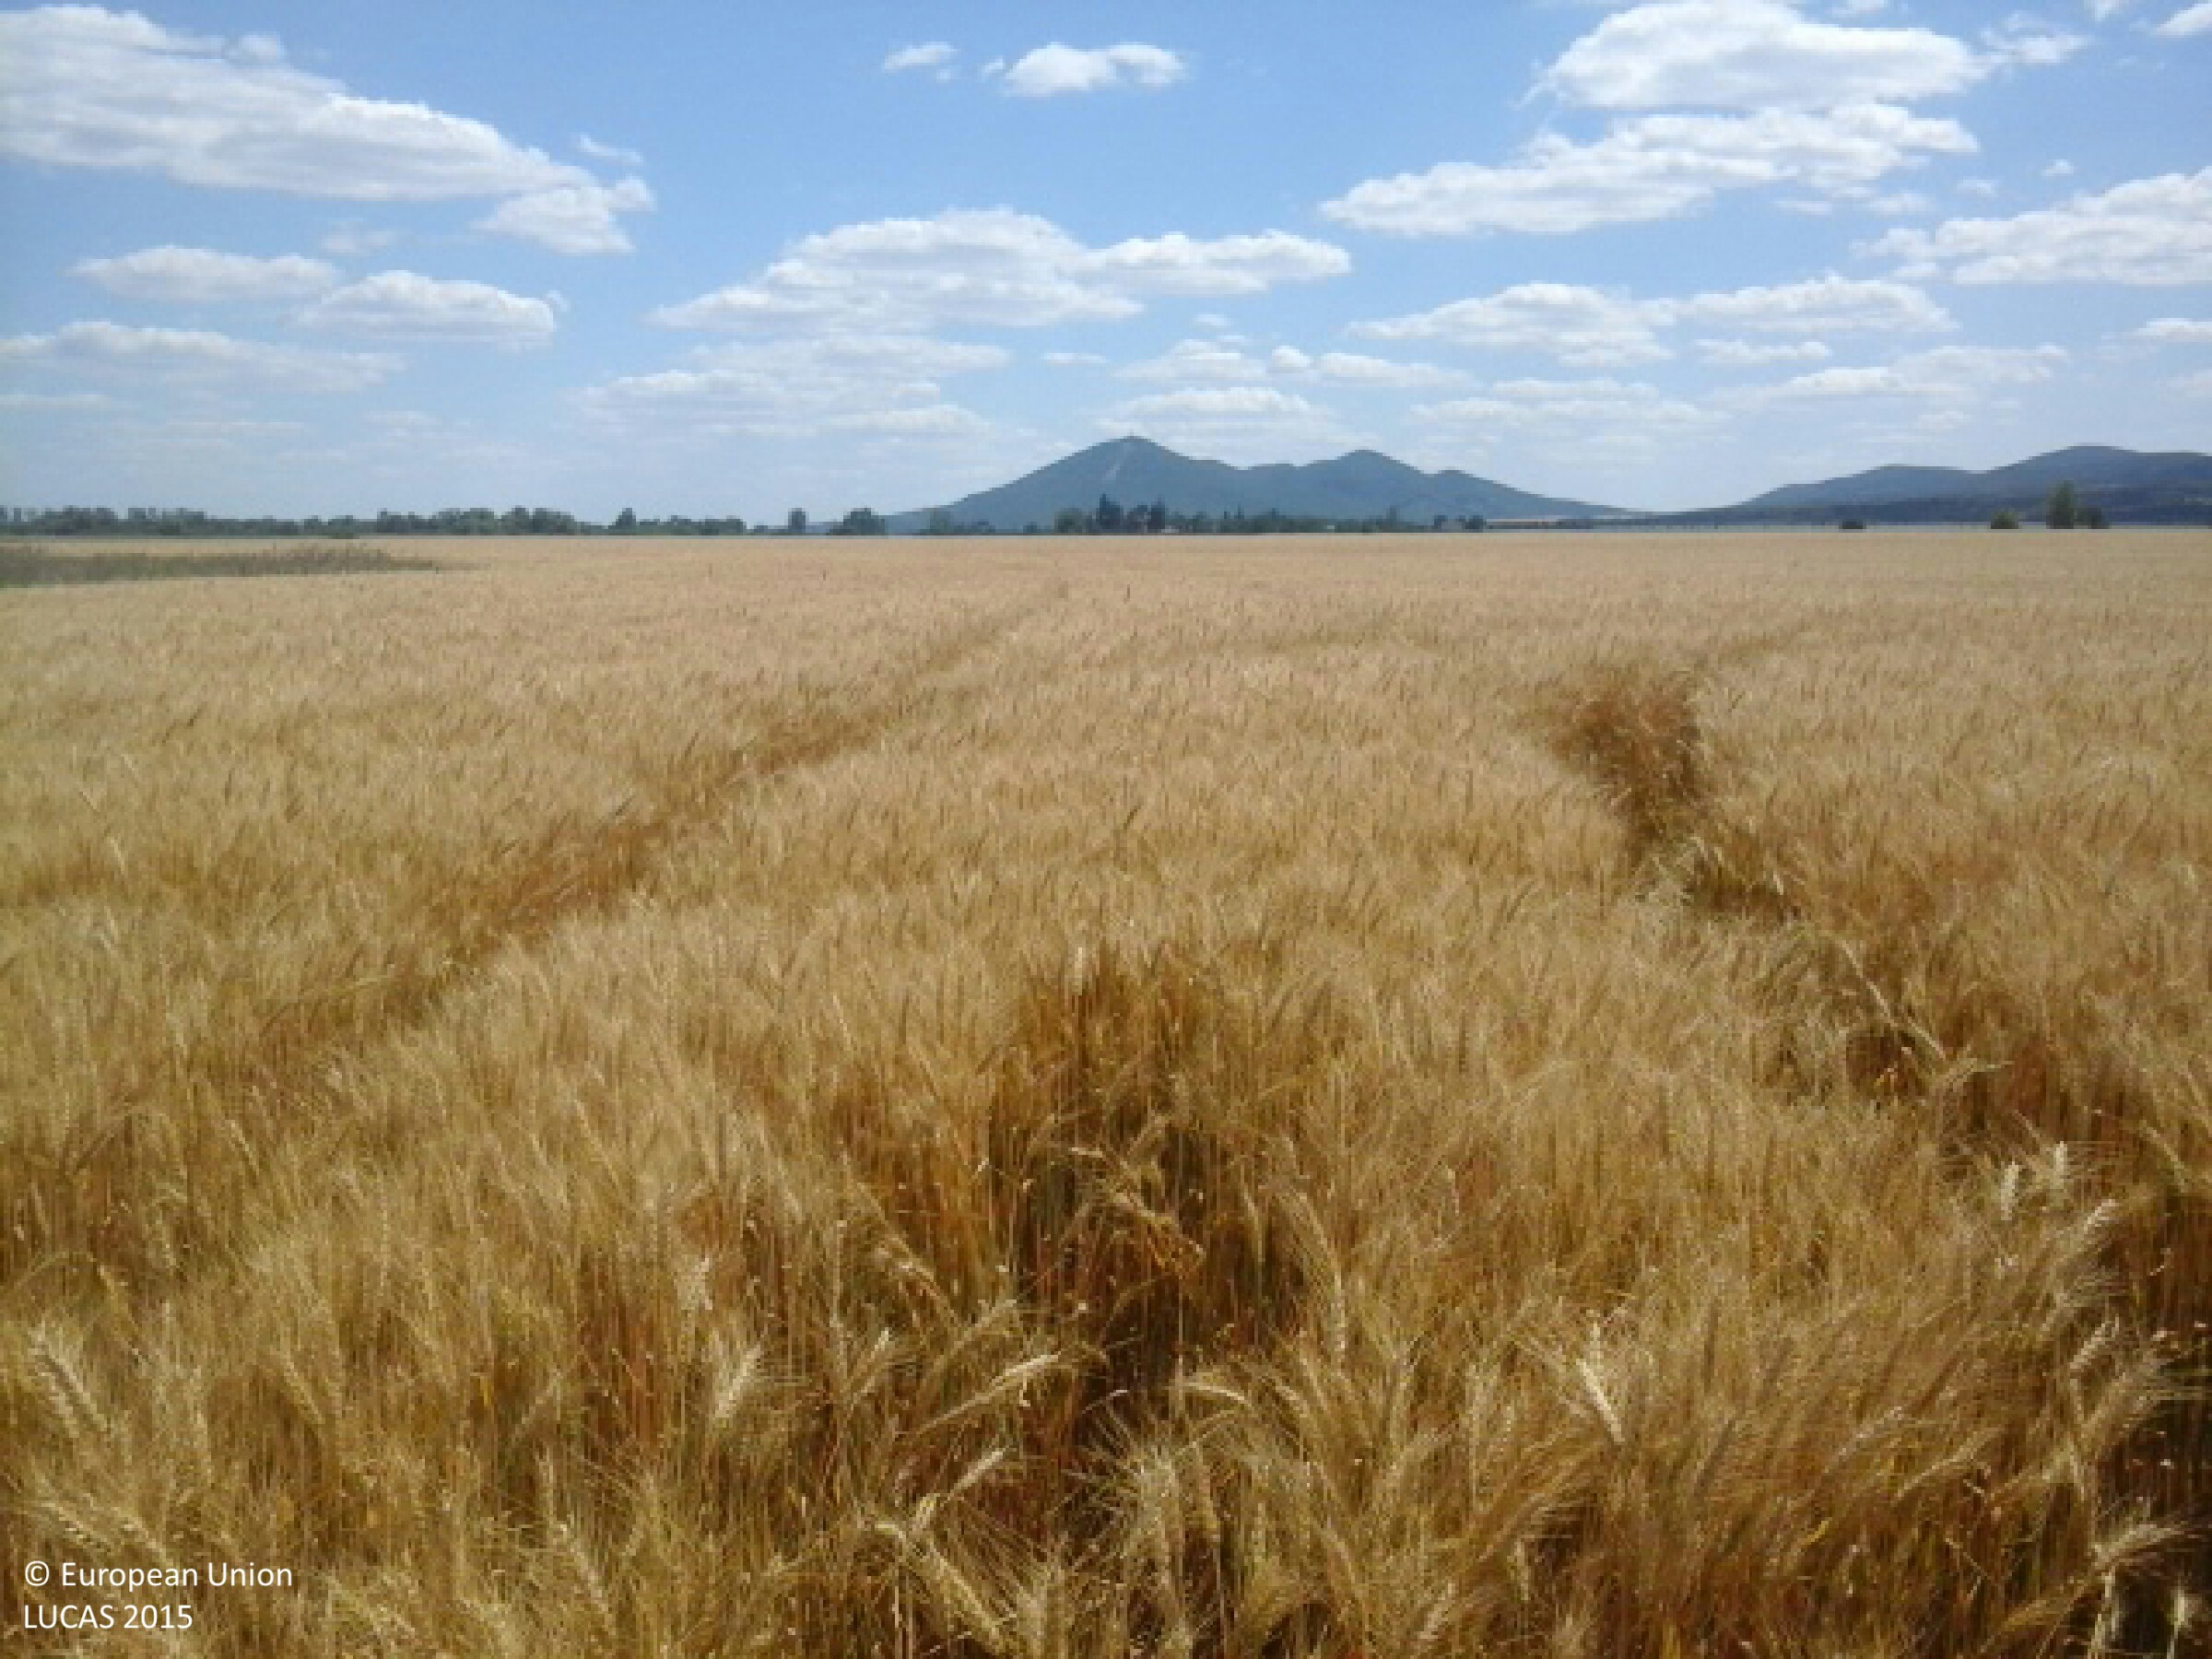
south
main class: Cropland
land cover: Triticale
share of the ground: > 75 %
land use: Agriculture (excluding fallow land and kitchen gardens)
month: July
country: HU
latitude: 48.4797
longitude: 21.6152
